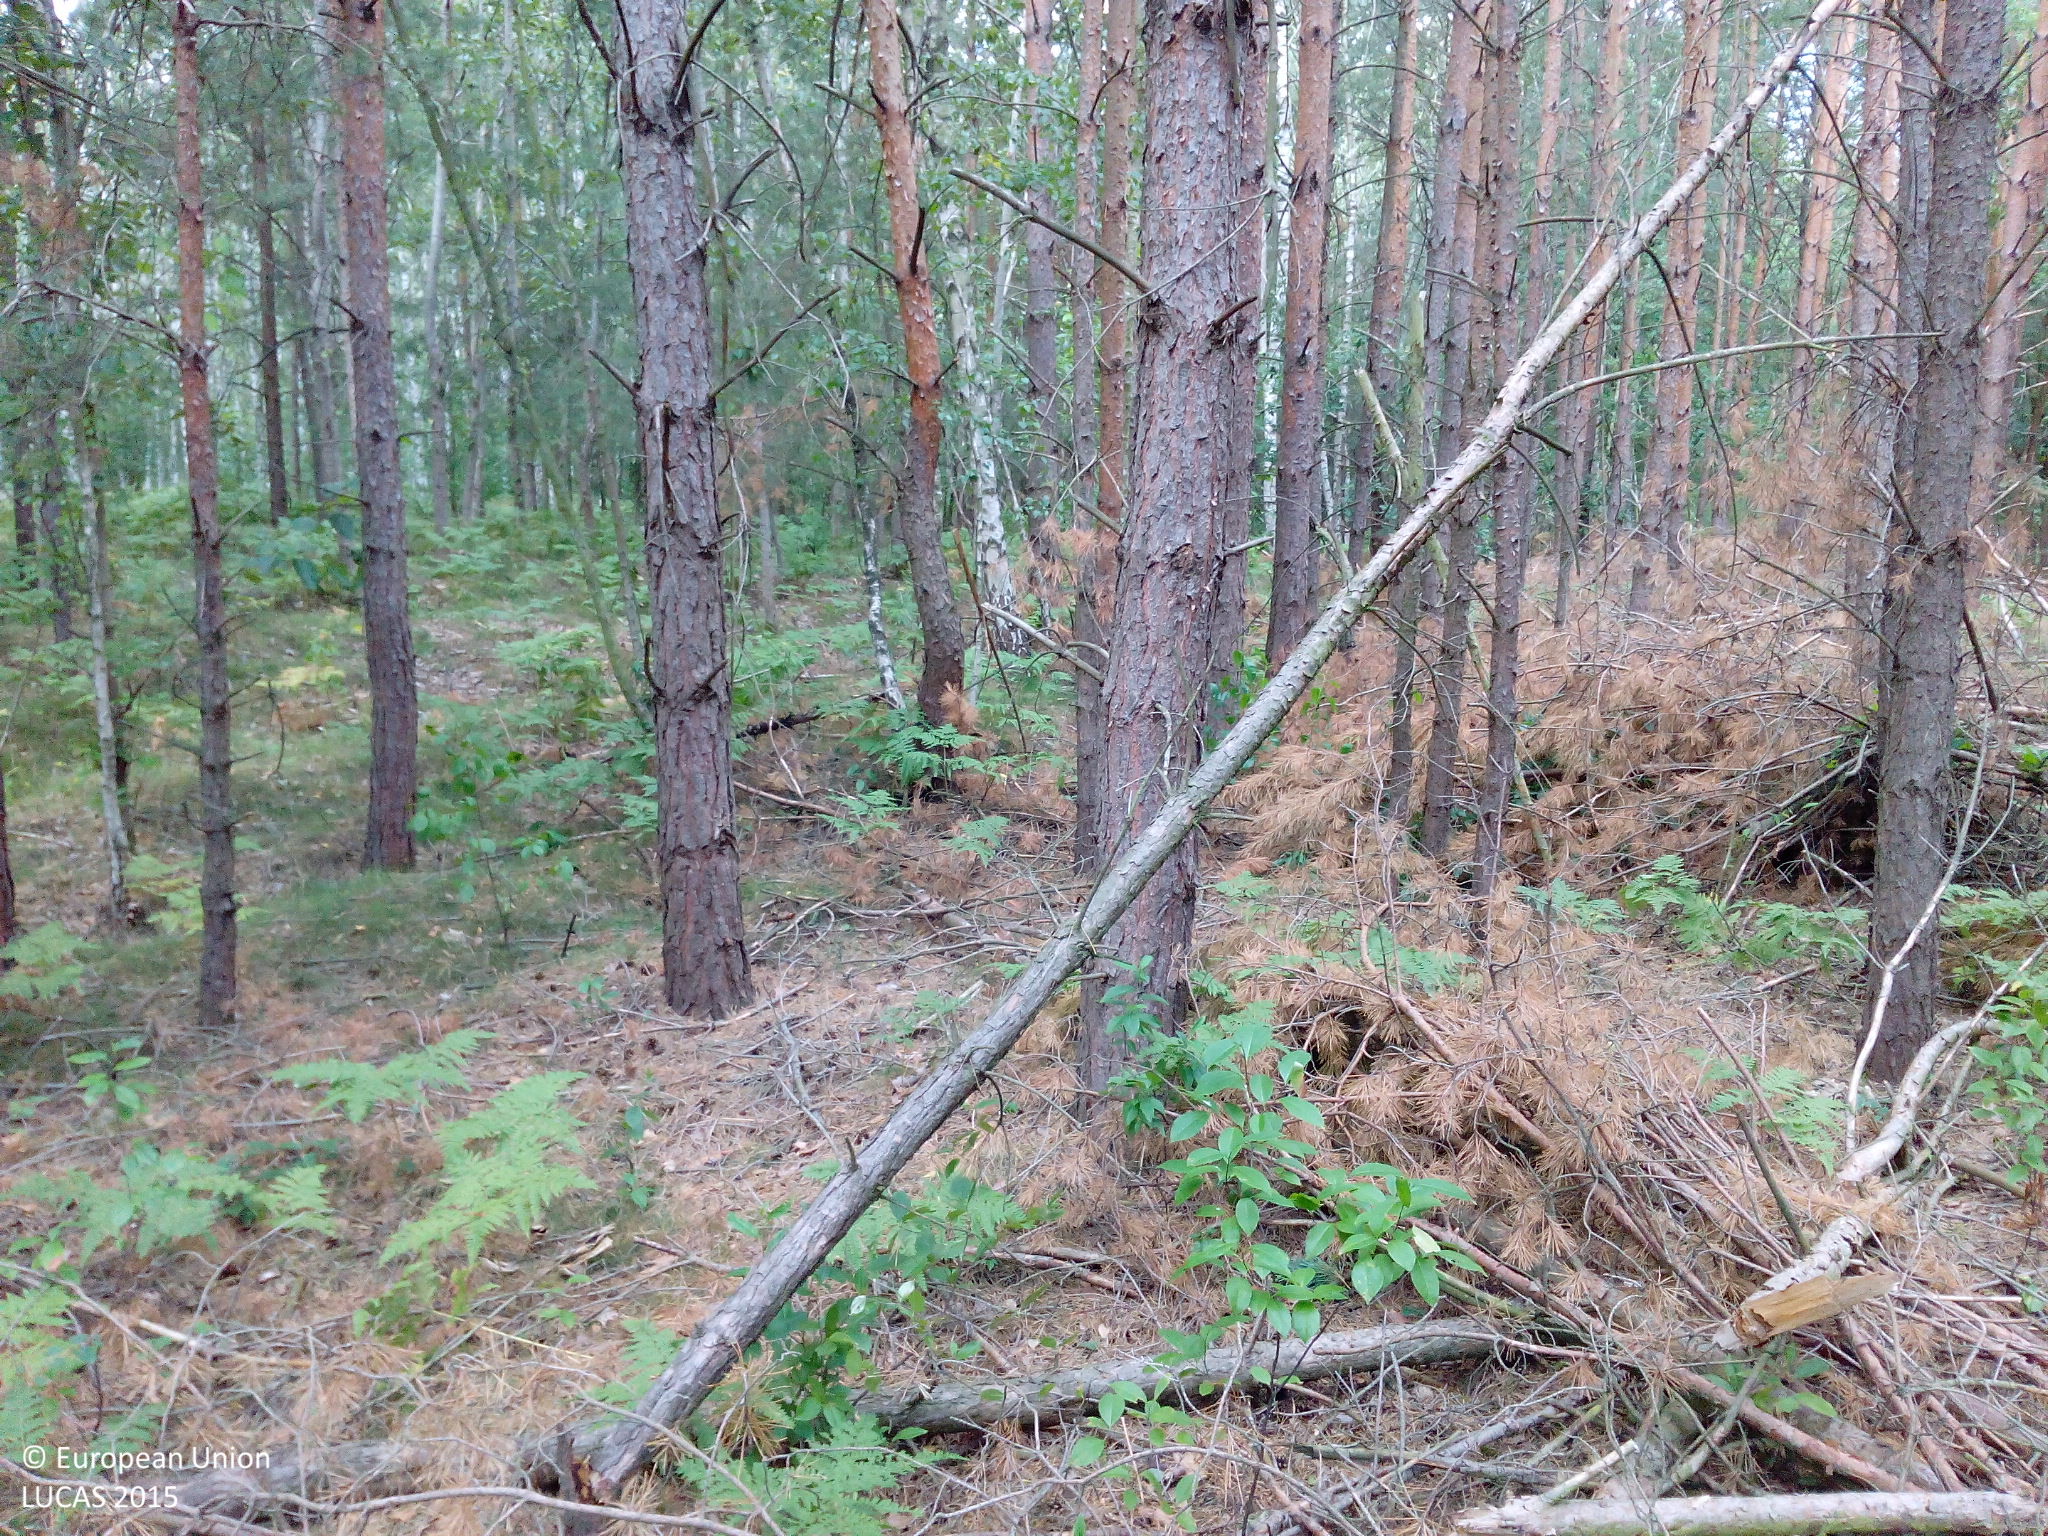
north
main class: Woodland
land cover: Pine dominated coniferous woodland
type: hemiboreal forest and nemoral coniferous forest and mixed broadleaved-coniferous forest
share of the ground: > 75 %
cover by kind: coniferous forest trees 80 %, herbaceous plants 15 %, broadleaved forest trees 5 %
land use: Forestry
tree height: > 5 m
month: July
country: DE
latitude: 52.4667
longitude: 13.6066
